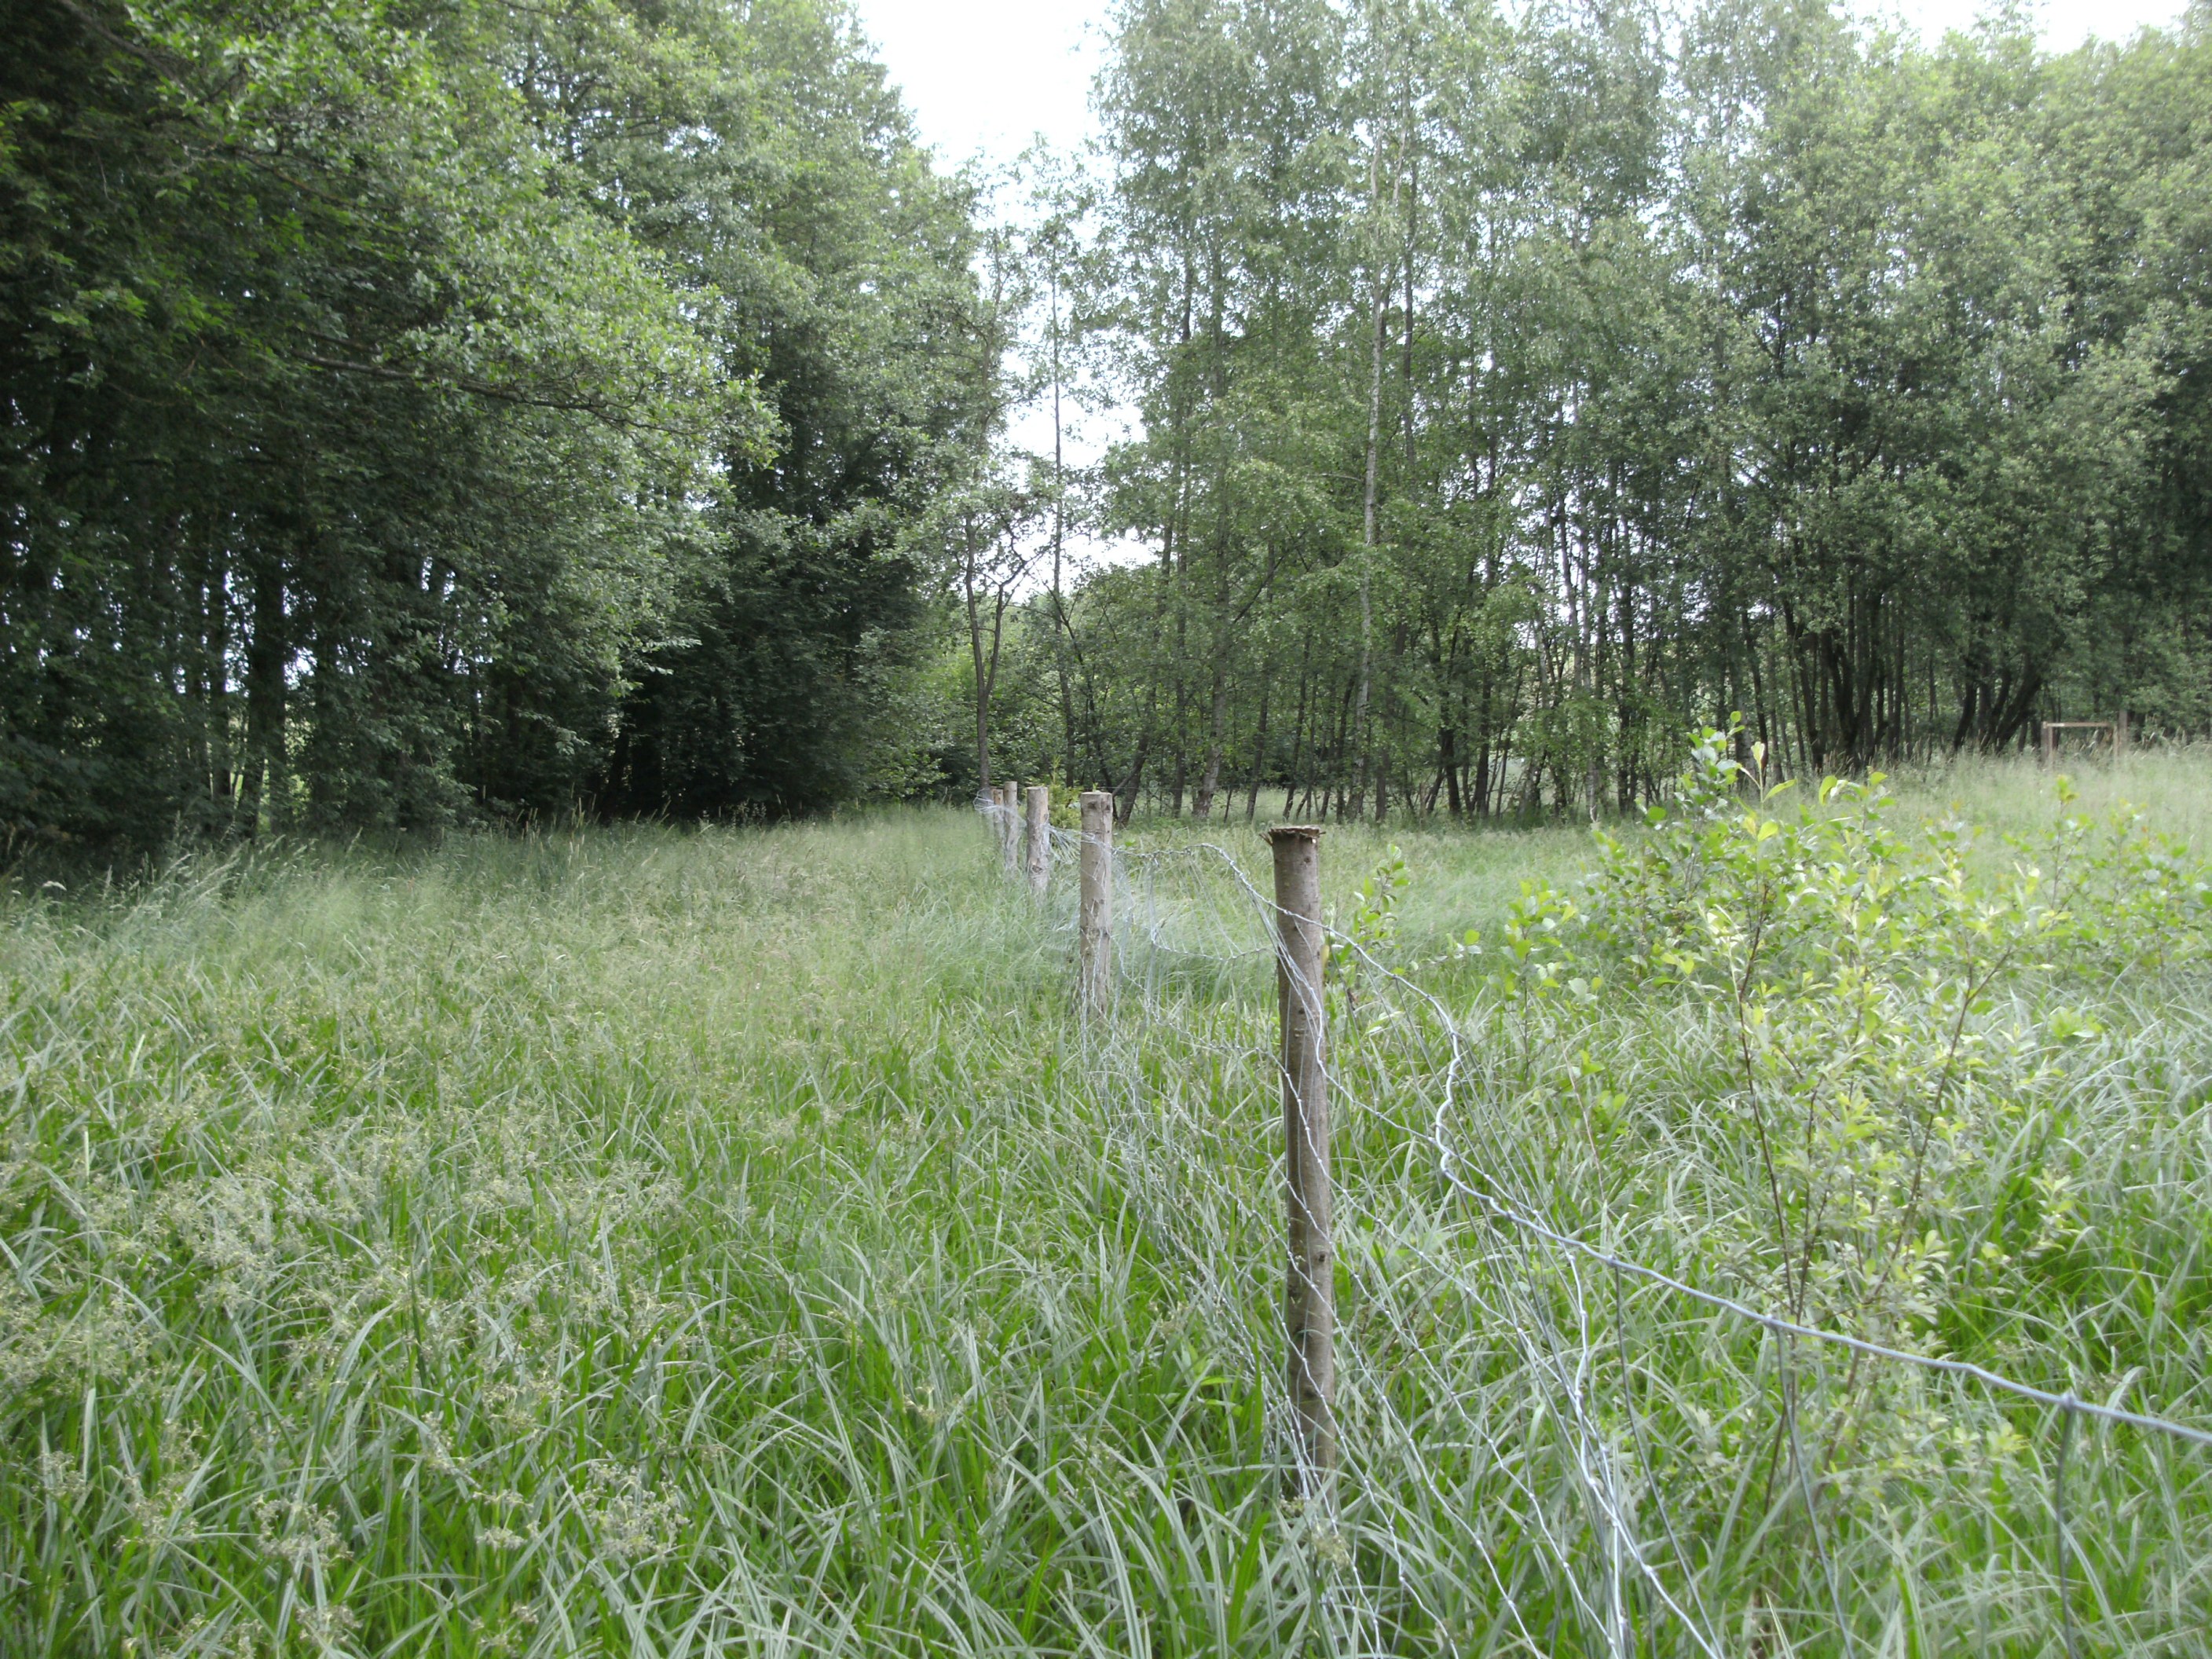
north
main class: Grassland
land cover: Grassland with sparse tree/shrub cover
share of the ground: > 75 %
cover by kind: herbaceous plants 95 %, broadleaved forest trees 5 %
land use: Agriculture (excluding fallow land and kitchen gardens)
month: May
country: AT
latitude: 48.1050
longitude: 13.7731
